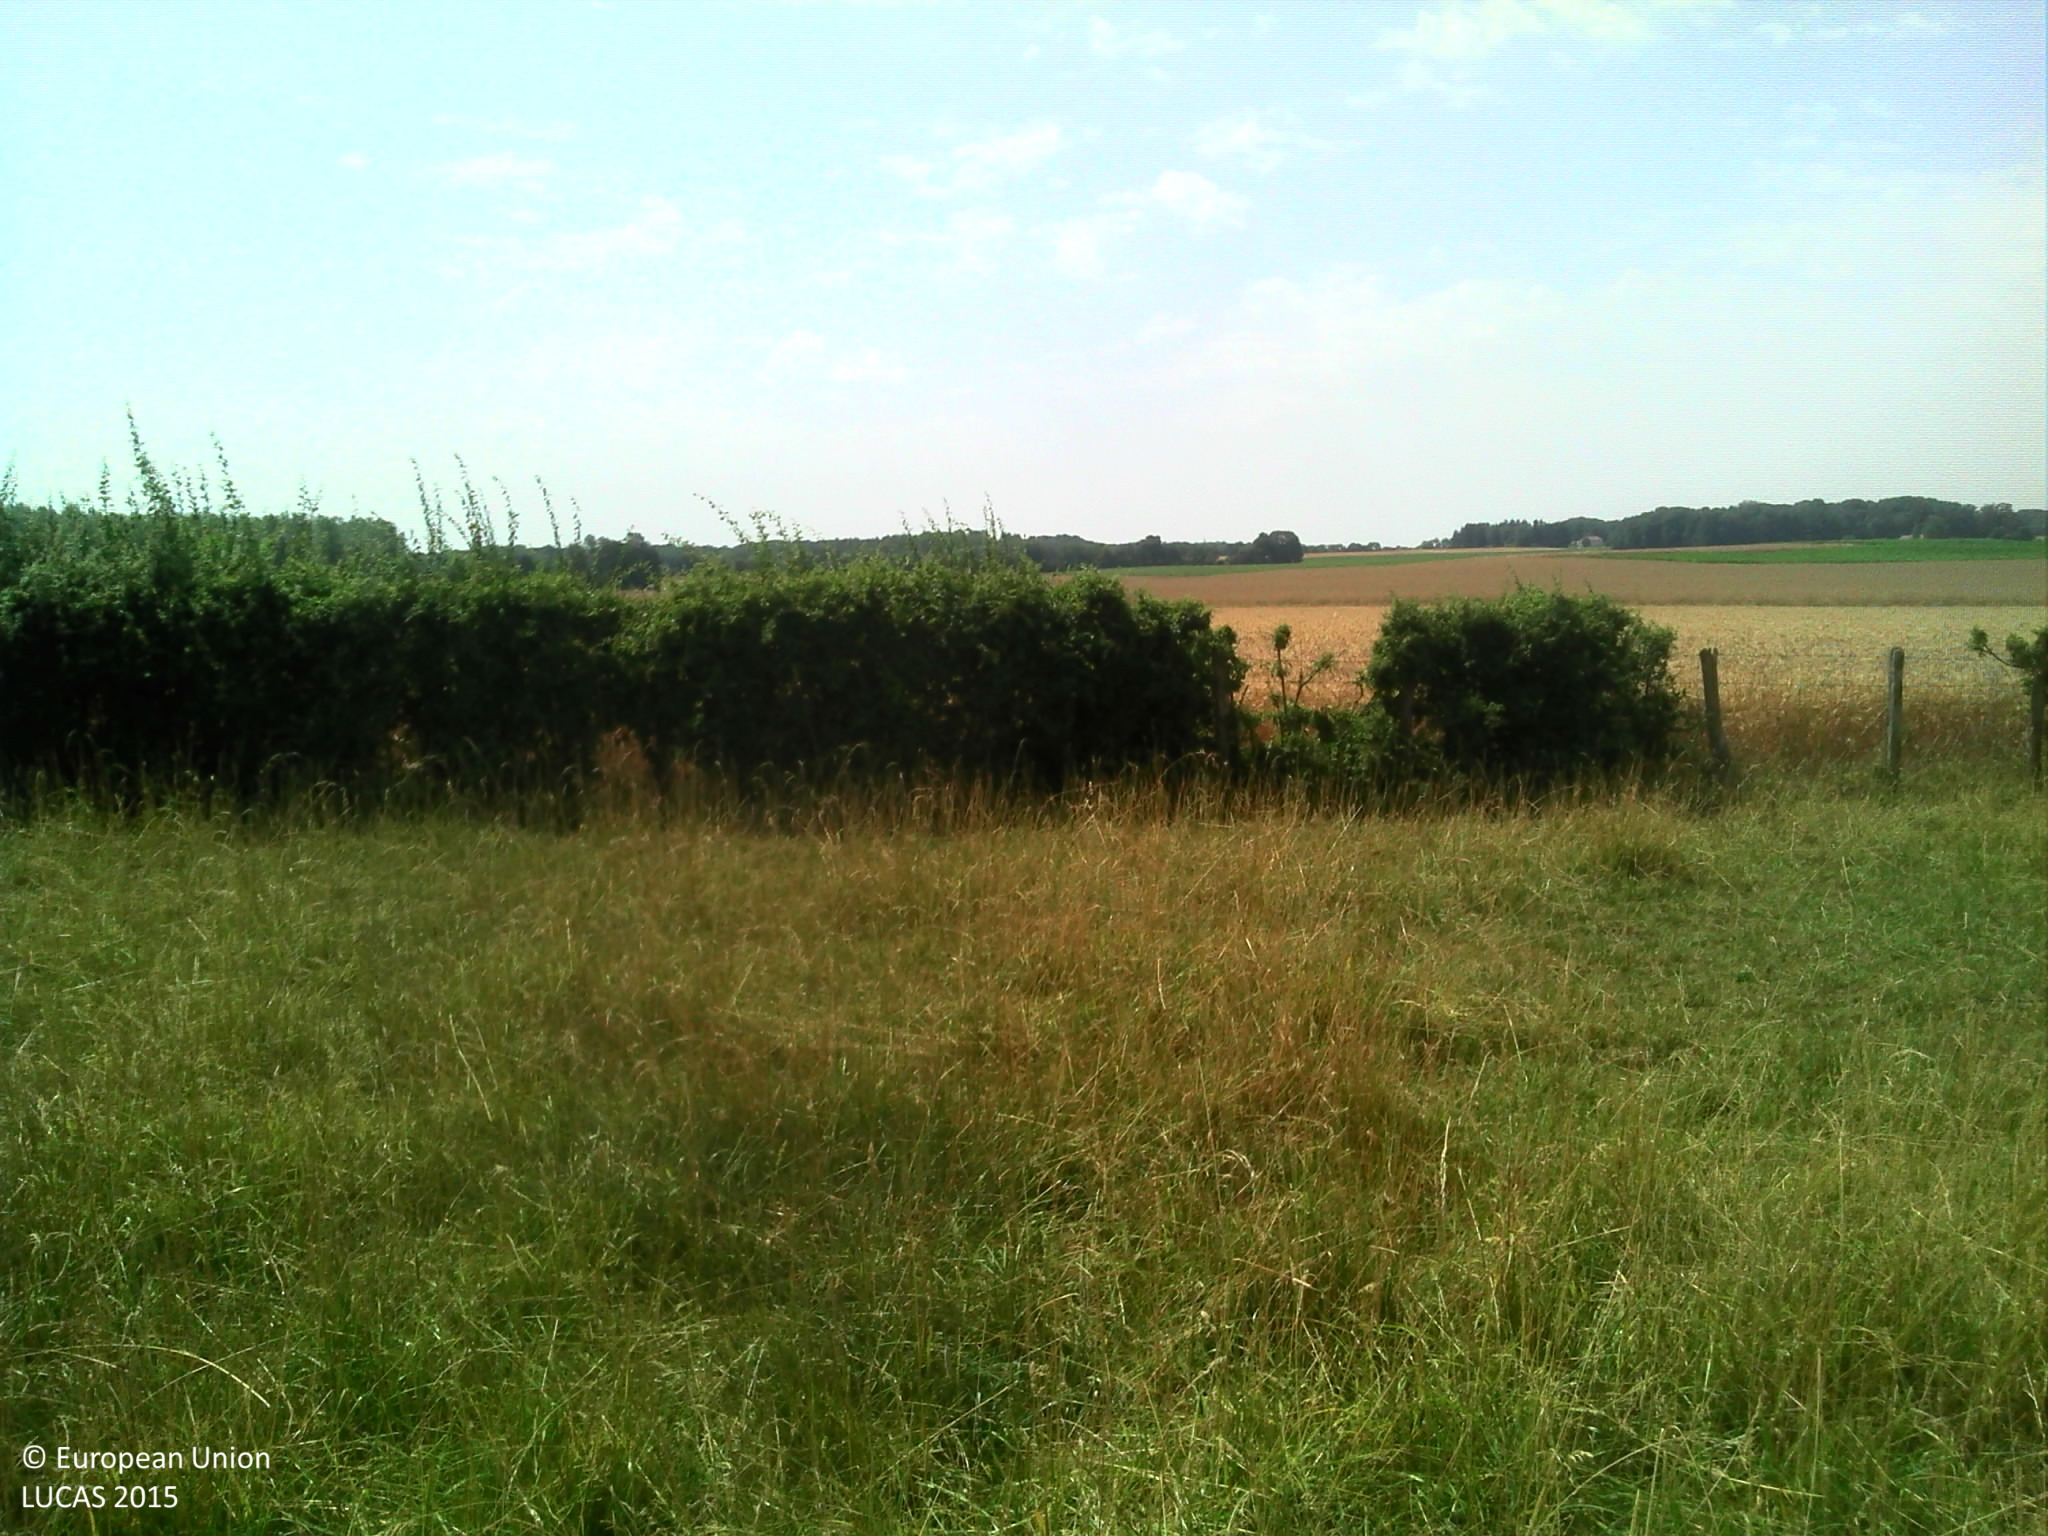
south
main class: Grassland
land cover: Grassland without tree/shrub cover
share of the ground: > 75 %
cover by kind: herbaceous plants 100 %
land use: Agriculture (excluding fallow land and kitchen gardens)
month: July
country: FR
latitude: 46.8969
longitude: 5.2894
